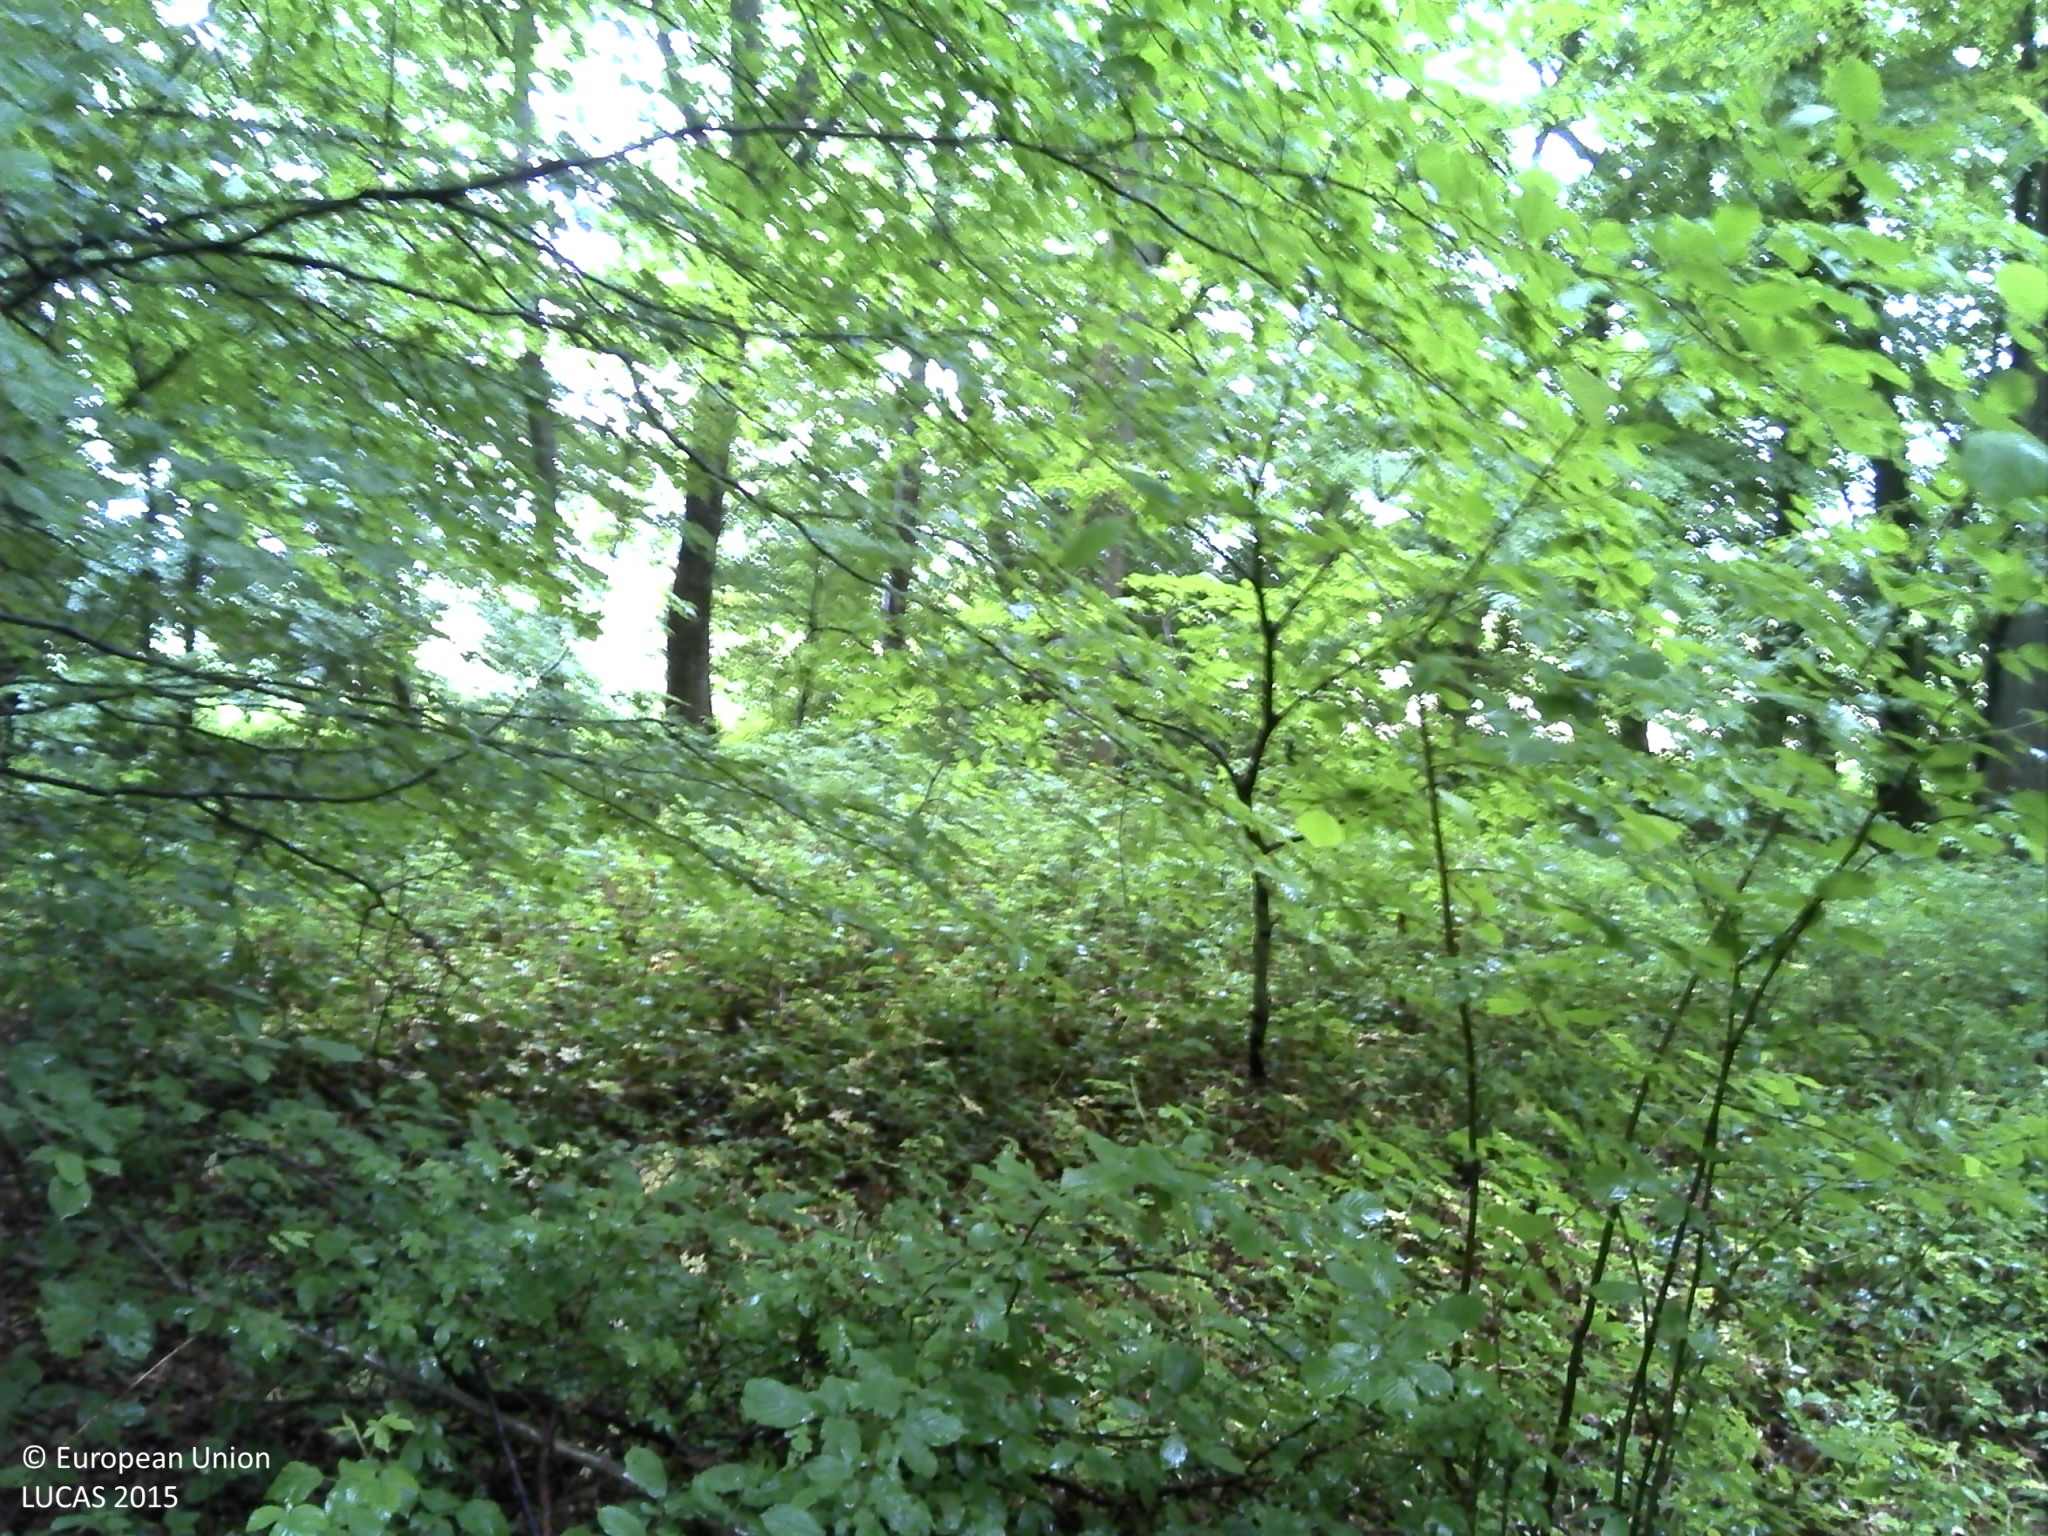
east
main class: Woodland
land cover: Broadleaved woodland
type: beech forest
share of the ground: > 75 %
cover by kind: broadleaved forest trees 95 %, herbaceous plants 5 %
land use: Forestry
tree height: > 5 m
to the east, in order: Broadleaved woodland; Ditches and canals; Grass margins; Temporary grasslands; Rape and turnip rape
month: June
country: FR
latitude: 48.9053
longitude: 6.4666
